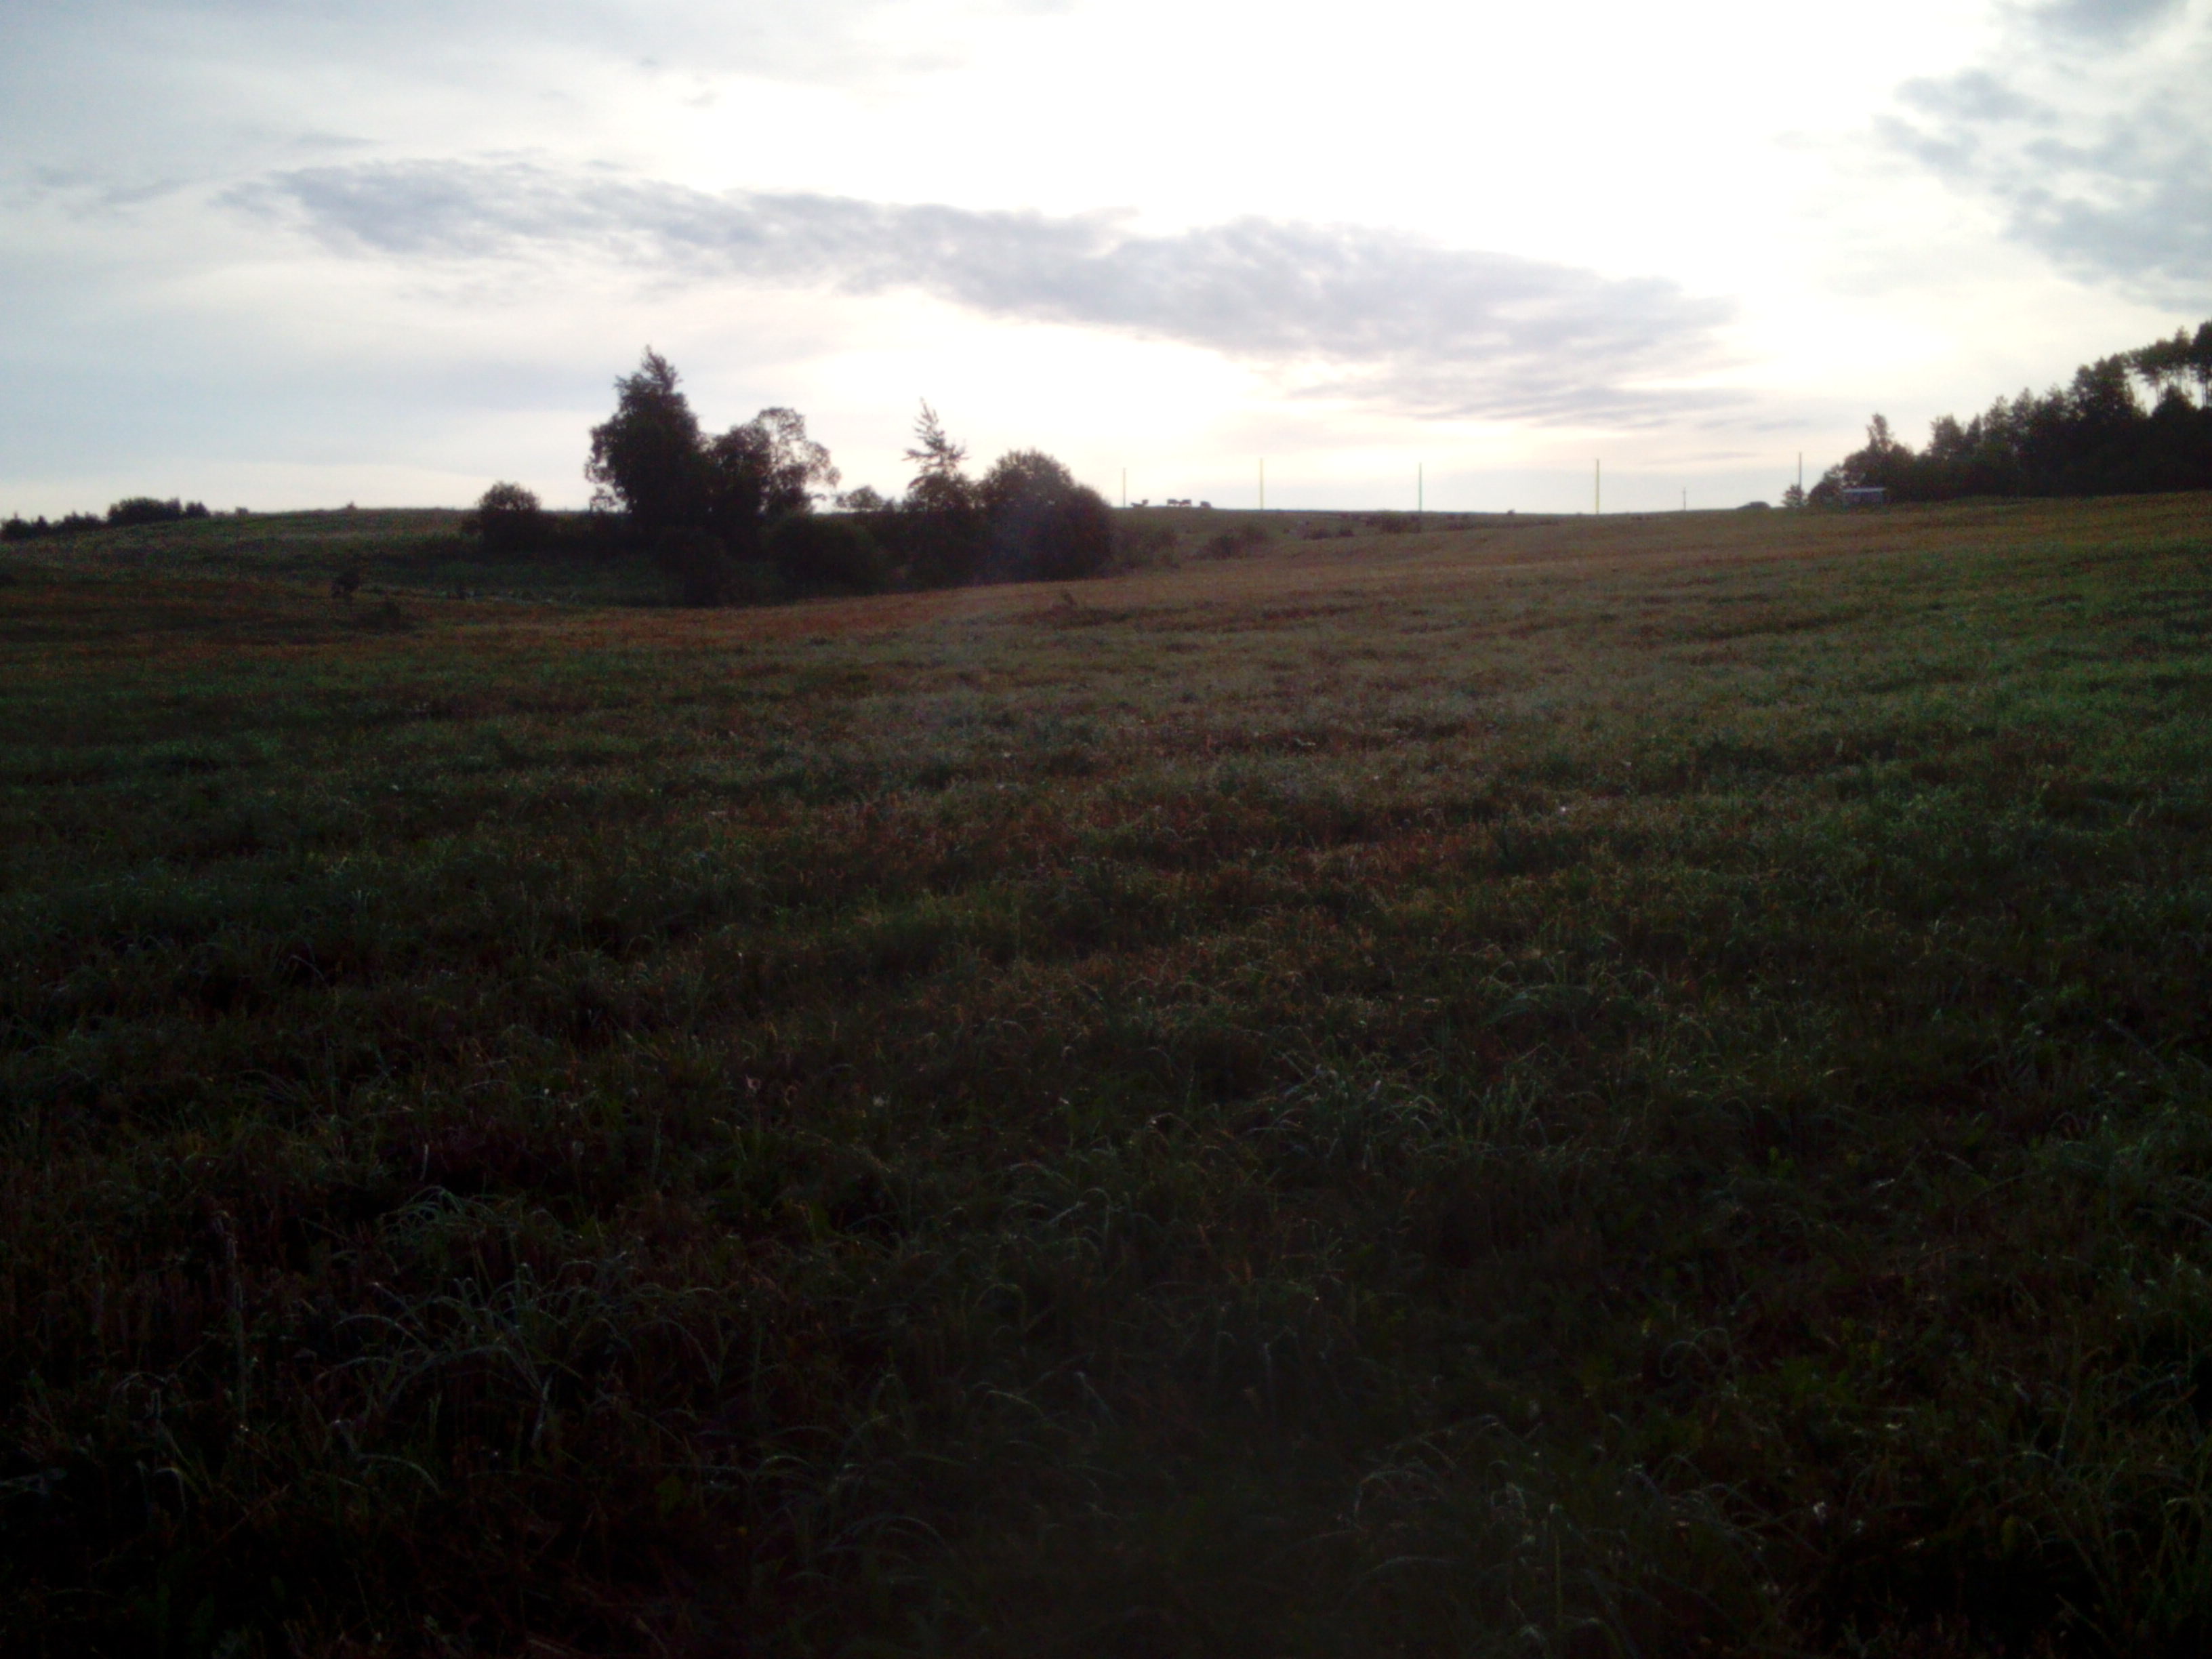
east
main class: Cropland
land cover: Common wheat
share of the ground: > 75 %
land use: Agriculture (excluding fallow land and kitchen gardens)
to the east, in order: Common wheat; Fences; Grassland without tree/shrub cover; Broadleaved woodland; Grassland without tree/shrub cover
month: September
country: LT
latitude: 55.7085
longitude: 22.4250
